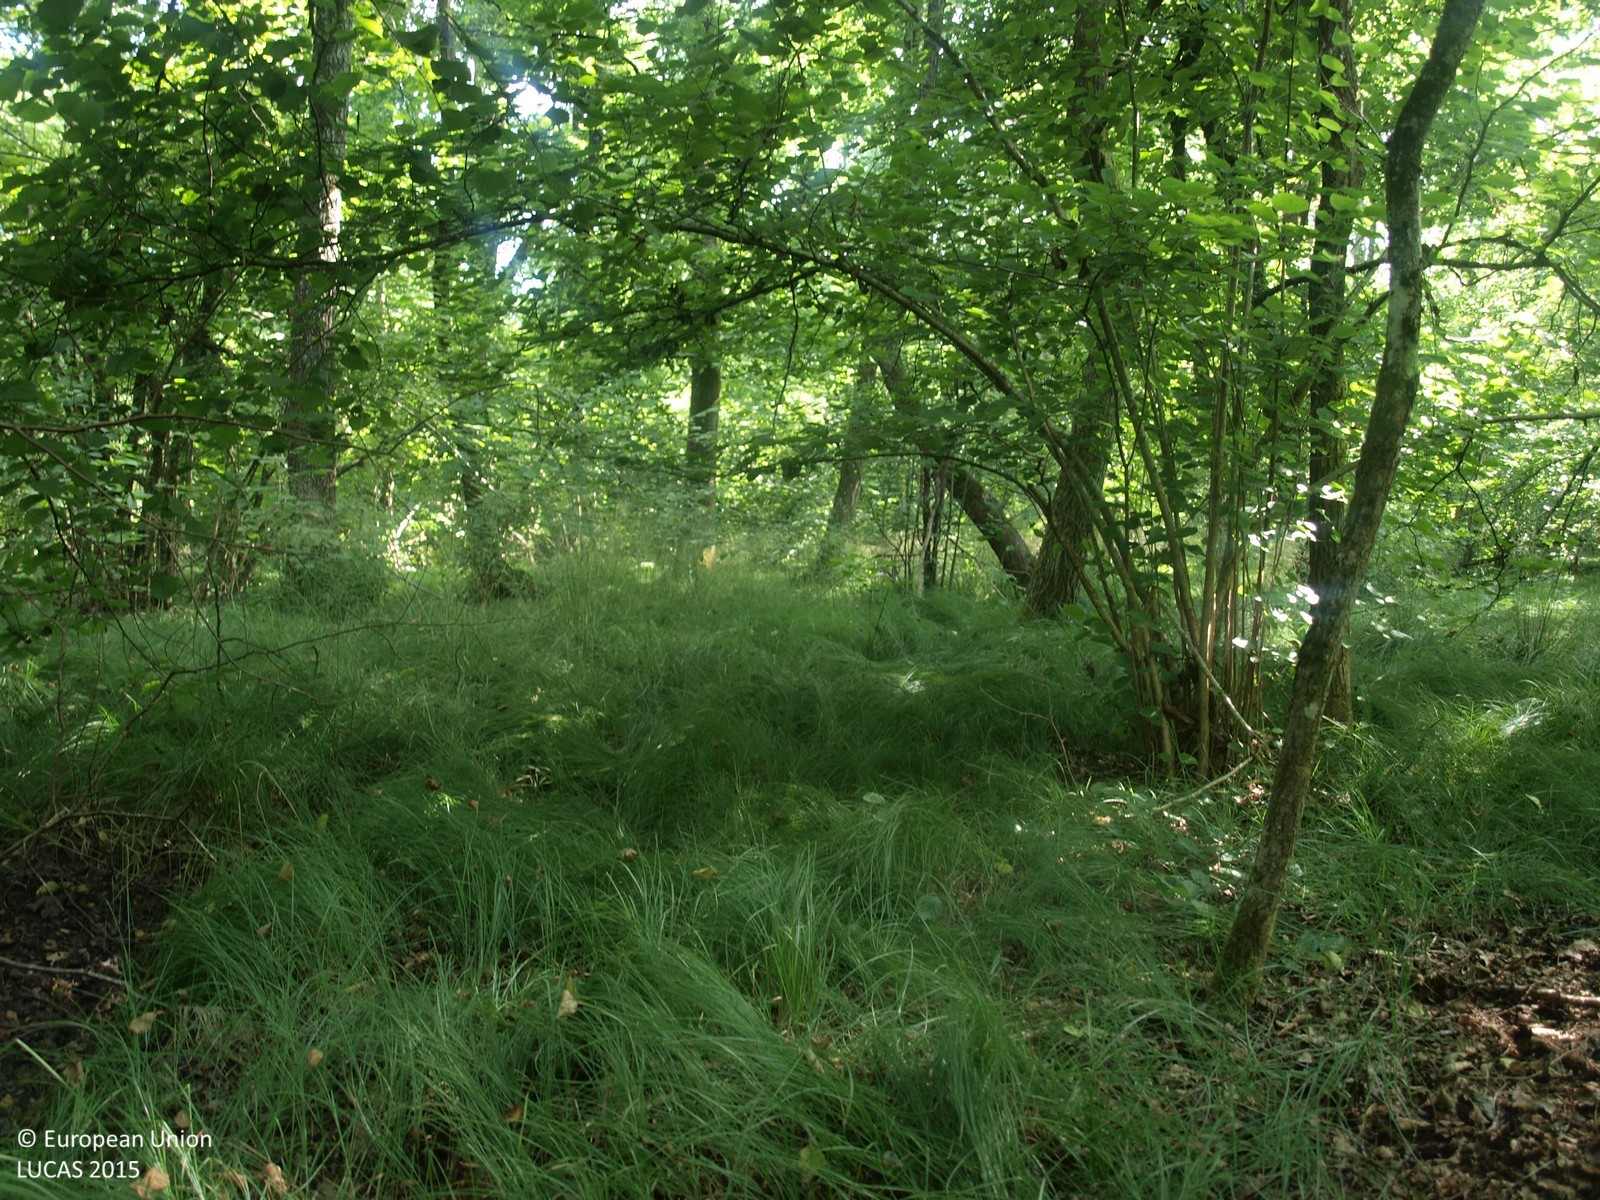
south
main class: Woodland
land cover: Broadleaved woodland
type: floodplain forest
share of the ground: > 75 %
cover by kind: broadleaved forest trees 100 %
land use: Forestry
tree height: > 5 m
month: July
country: HR
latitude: 45.6571
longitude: 15.7078
